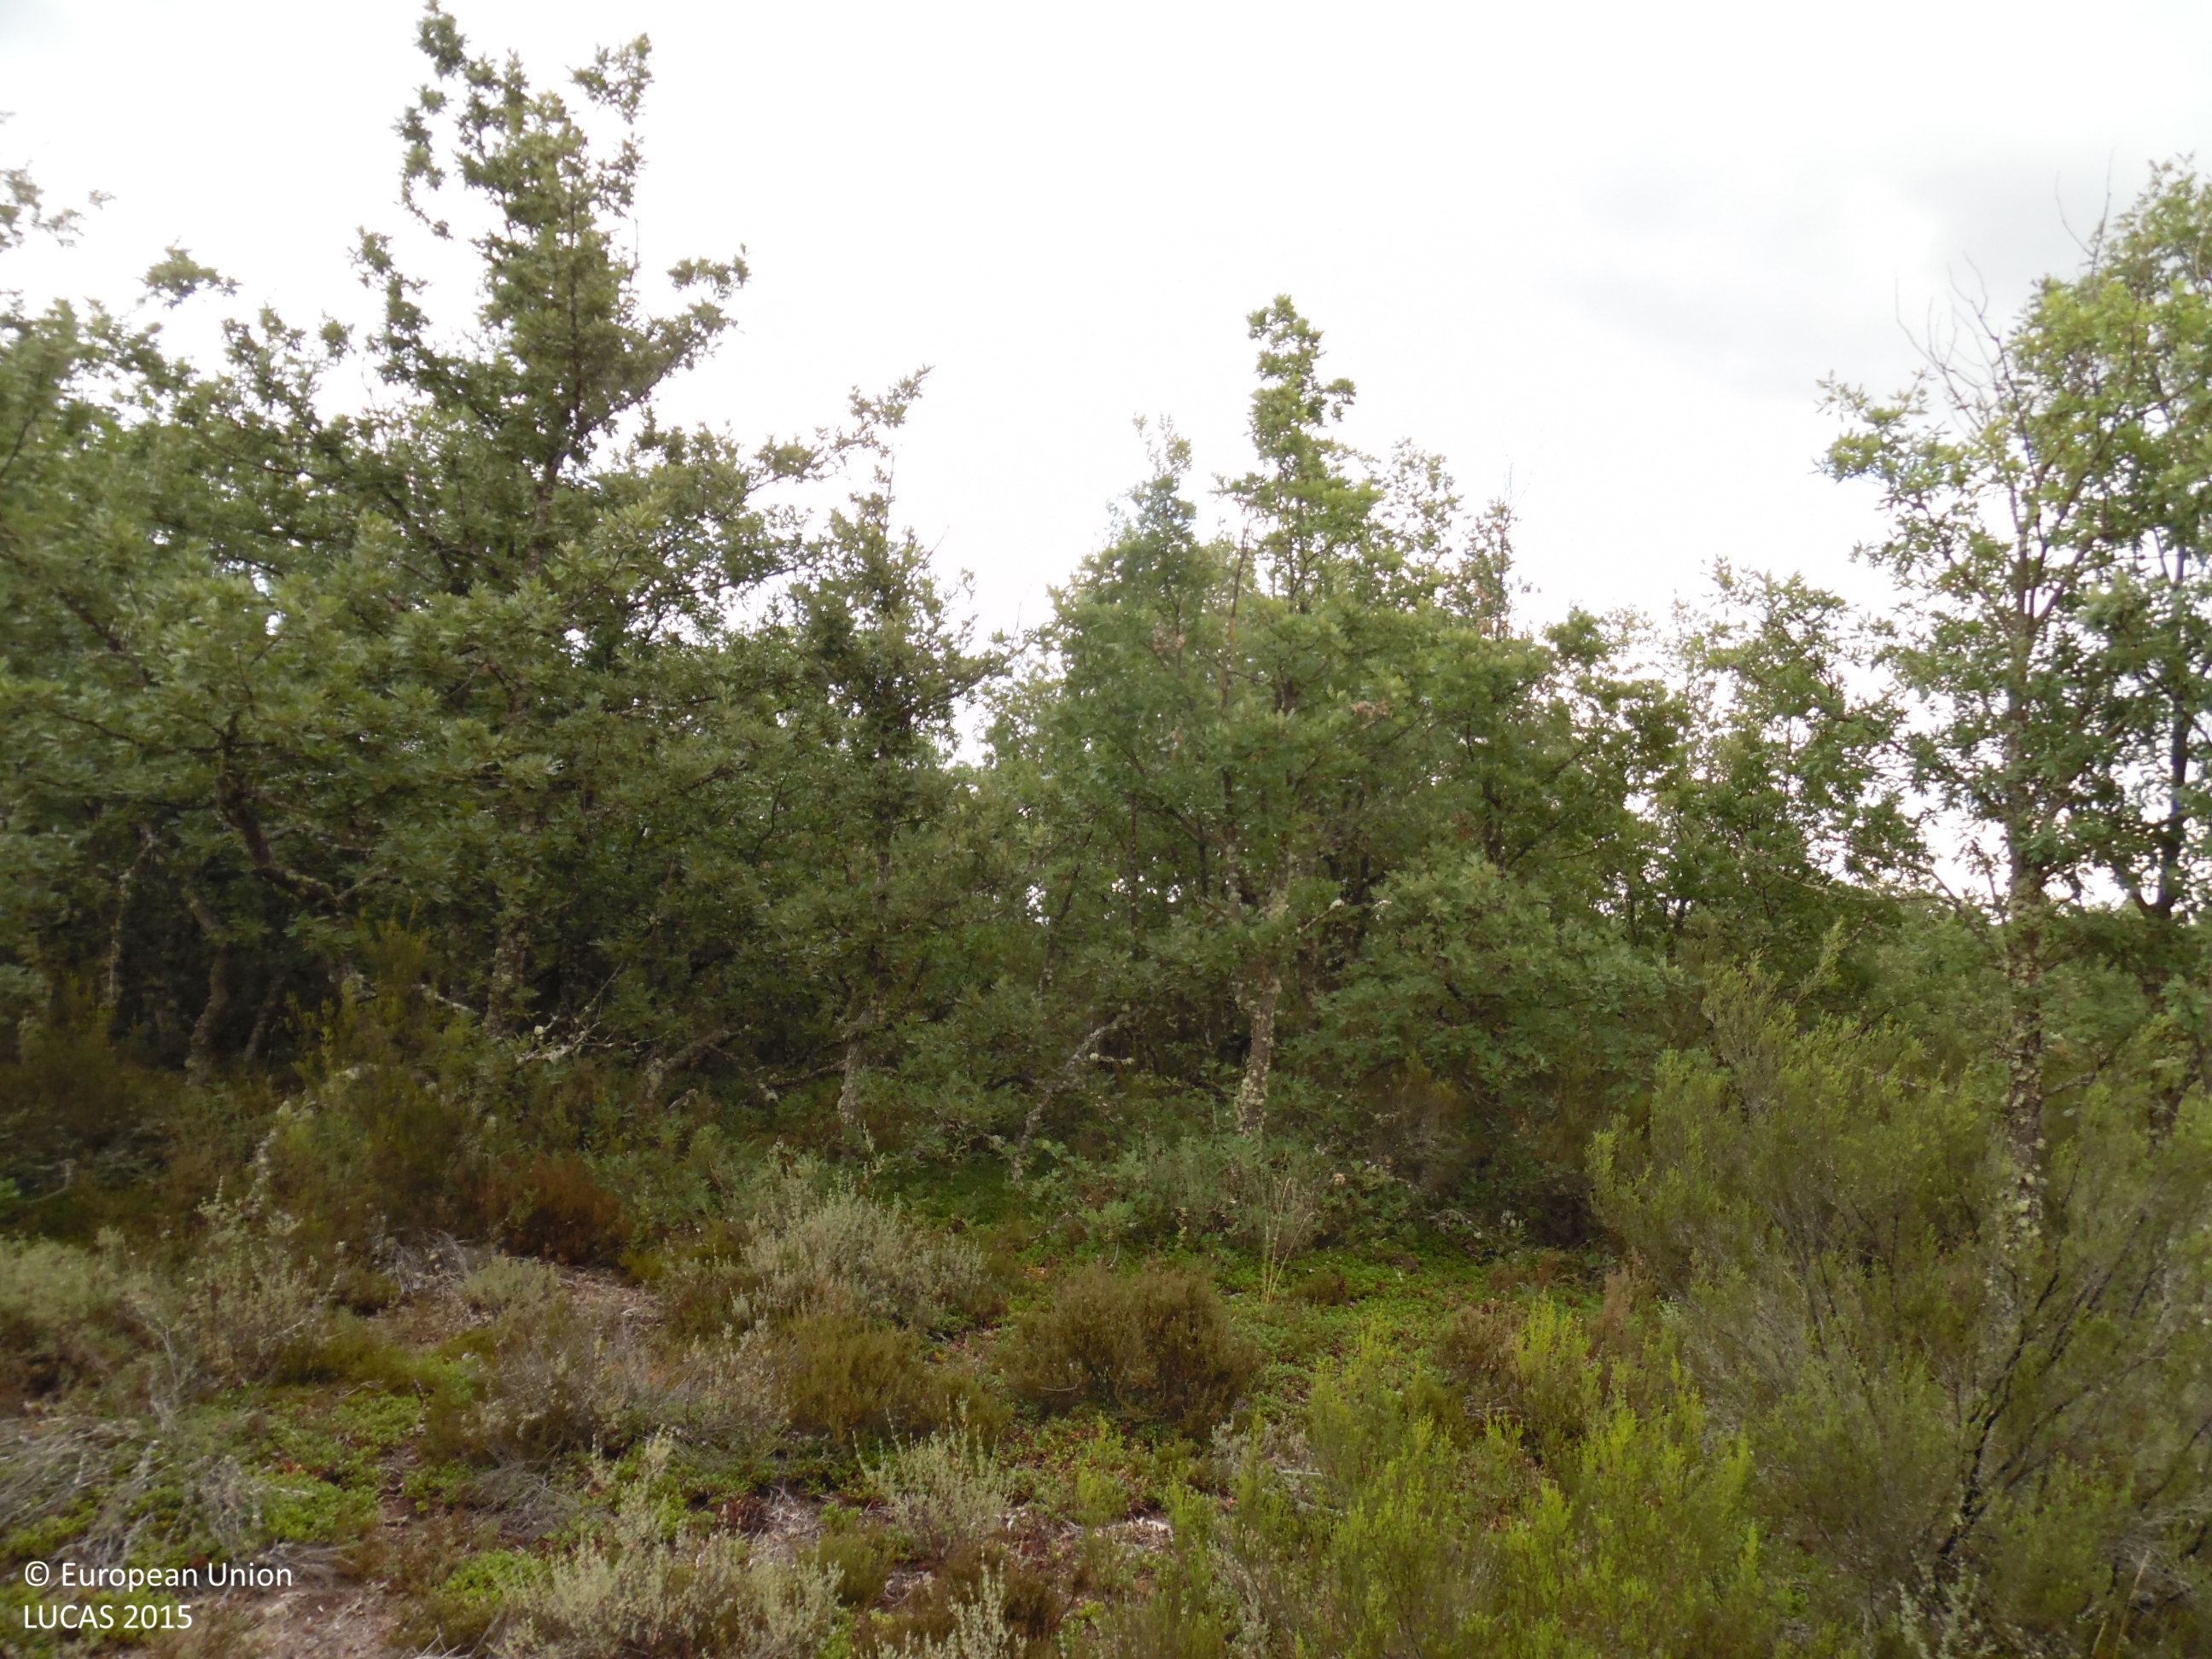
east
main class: Woodland
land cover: Broadleaved woodland
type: broadleaved evergreen forest
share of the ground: > 75 %
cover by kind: broadleaved forest trees 90 %, shrubs 10 %
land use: Forestry
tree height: > 5 m
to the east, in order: Broadleaved woodland; Shrubland with sparse tree cover; Broadleaved woodland; Shrubland with sparse tree cover; Tracks; Shrubland with sparse tree cover; Fences; Paved roads, cycling and walking lanes; Fences; Shrubland without tree cover; Shrubland with sparse tree cover
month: July
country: ES
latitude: 42.6256
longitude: -5.7447
